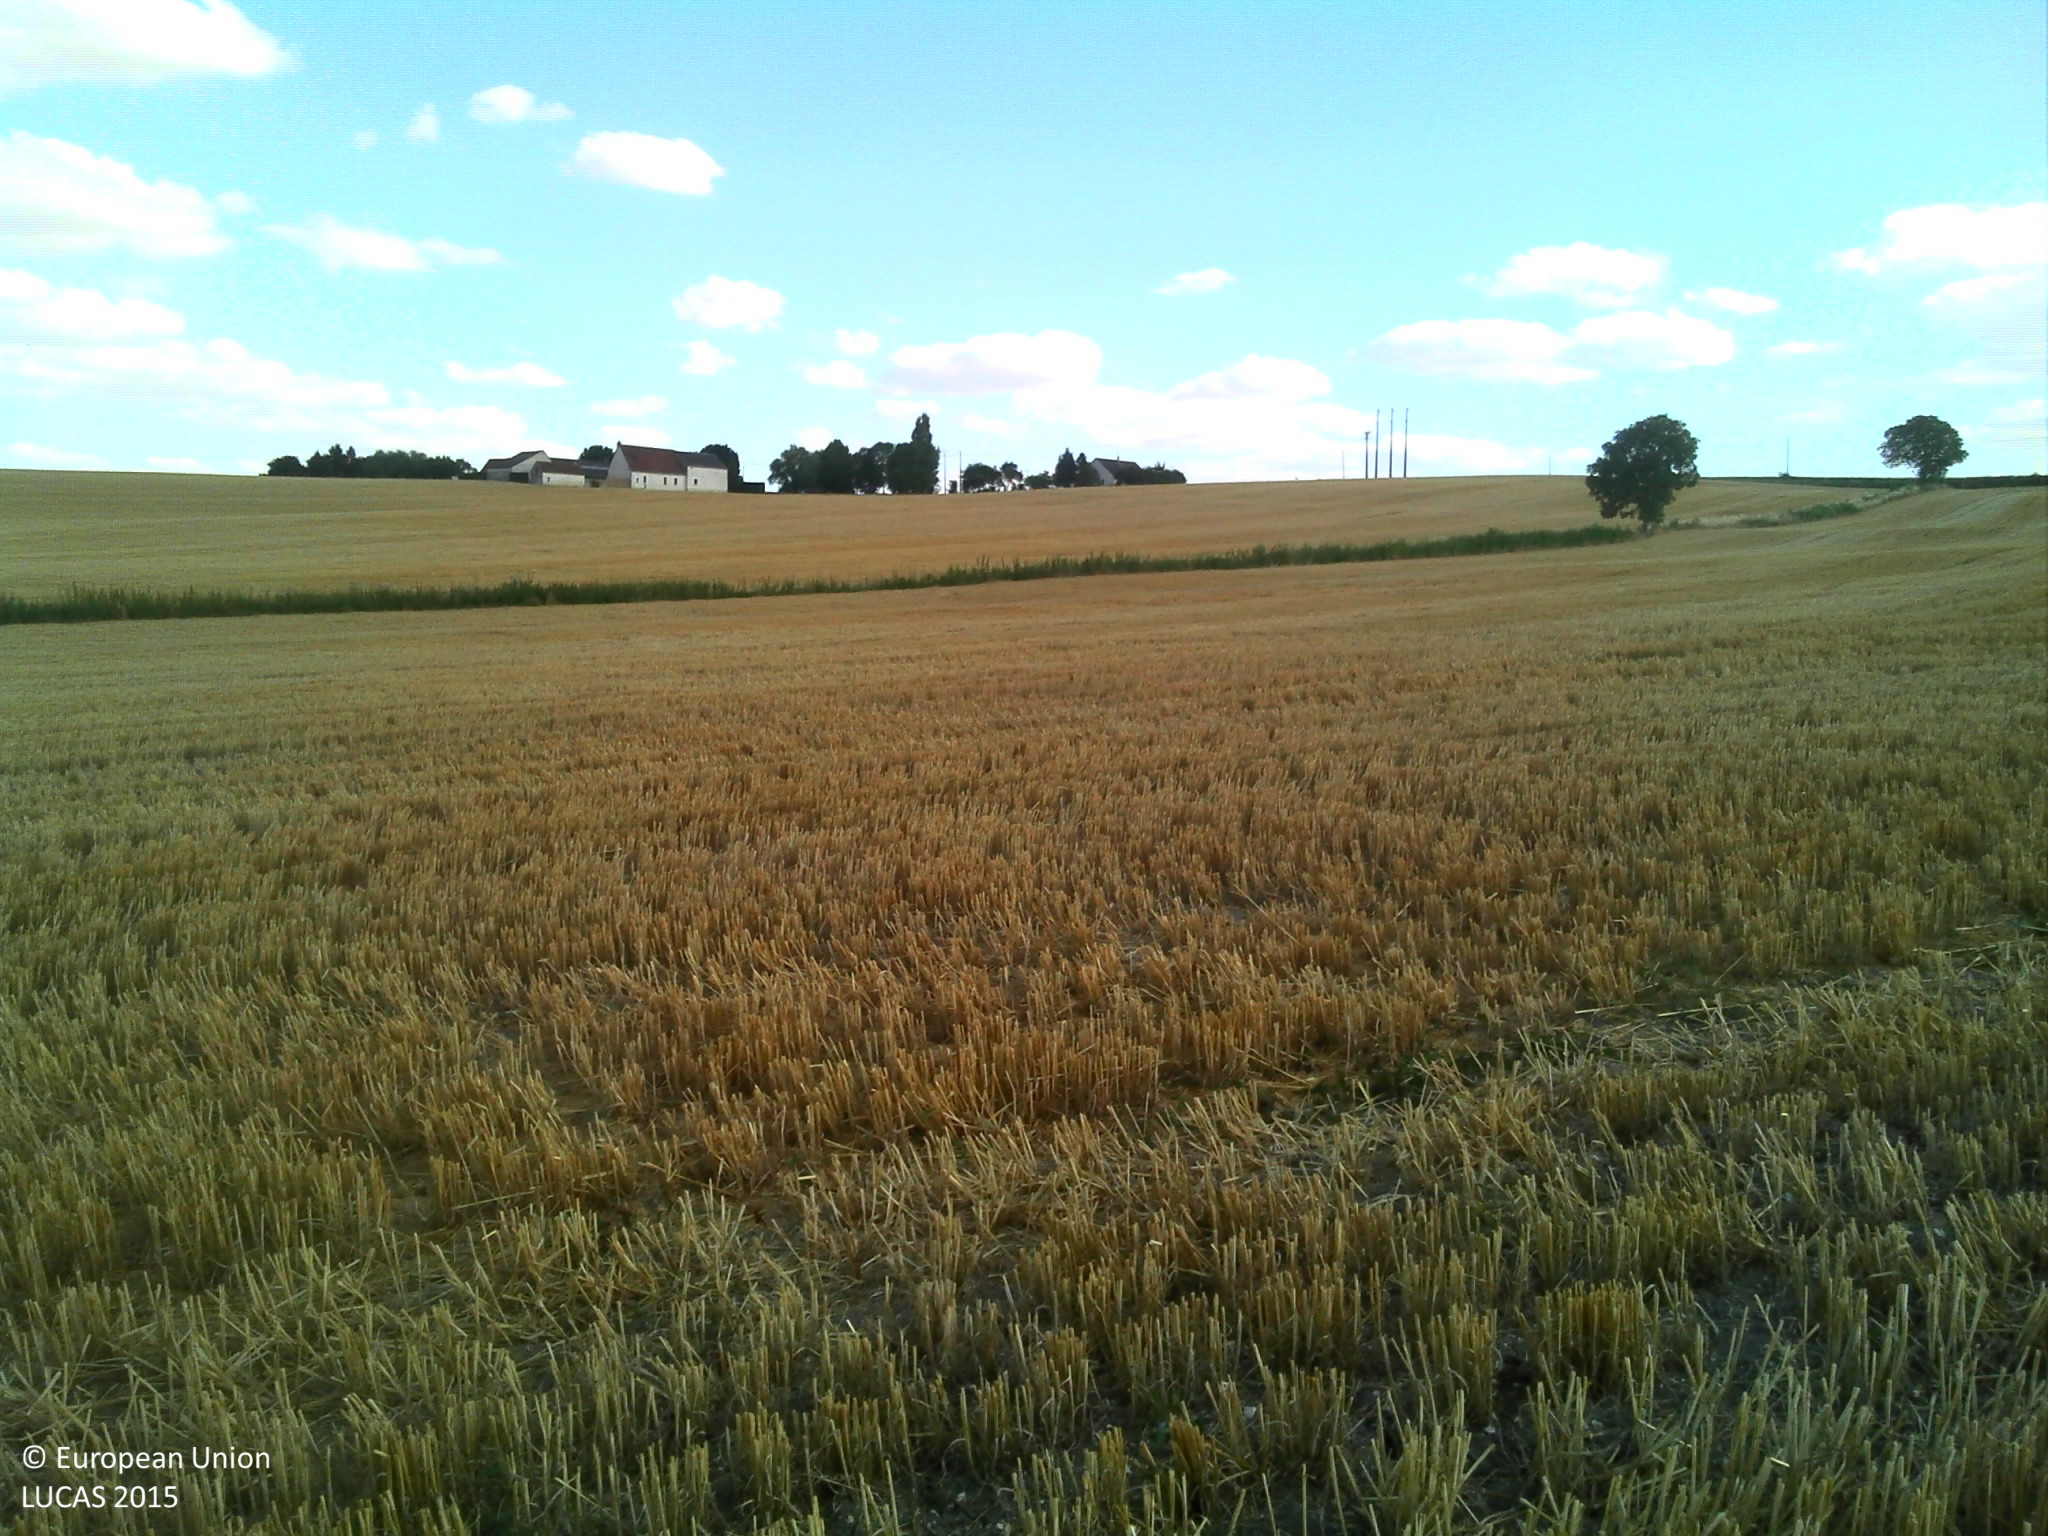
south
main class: Cropland
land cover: Common wheat
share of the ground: > 75 %
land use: Agriculture (excluding fallow land and kitchen gardens)
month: July
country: FR
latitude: 47.0821
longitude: 0.8553
